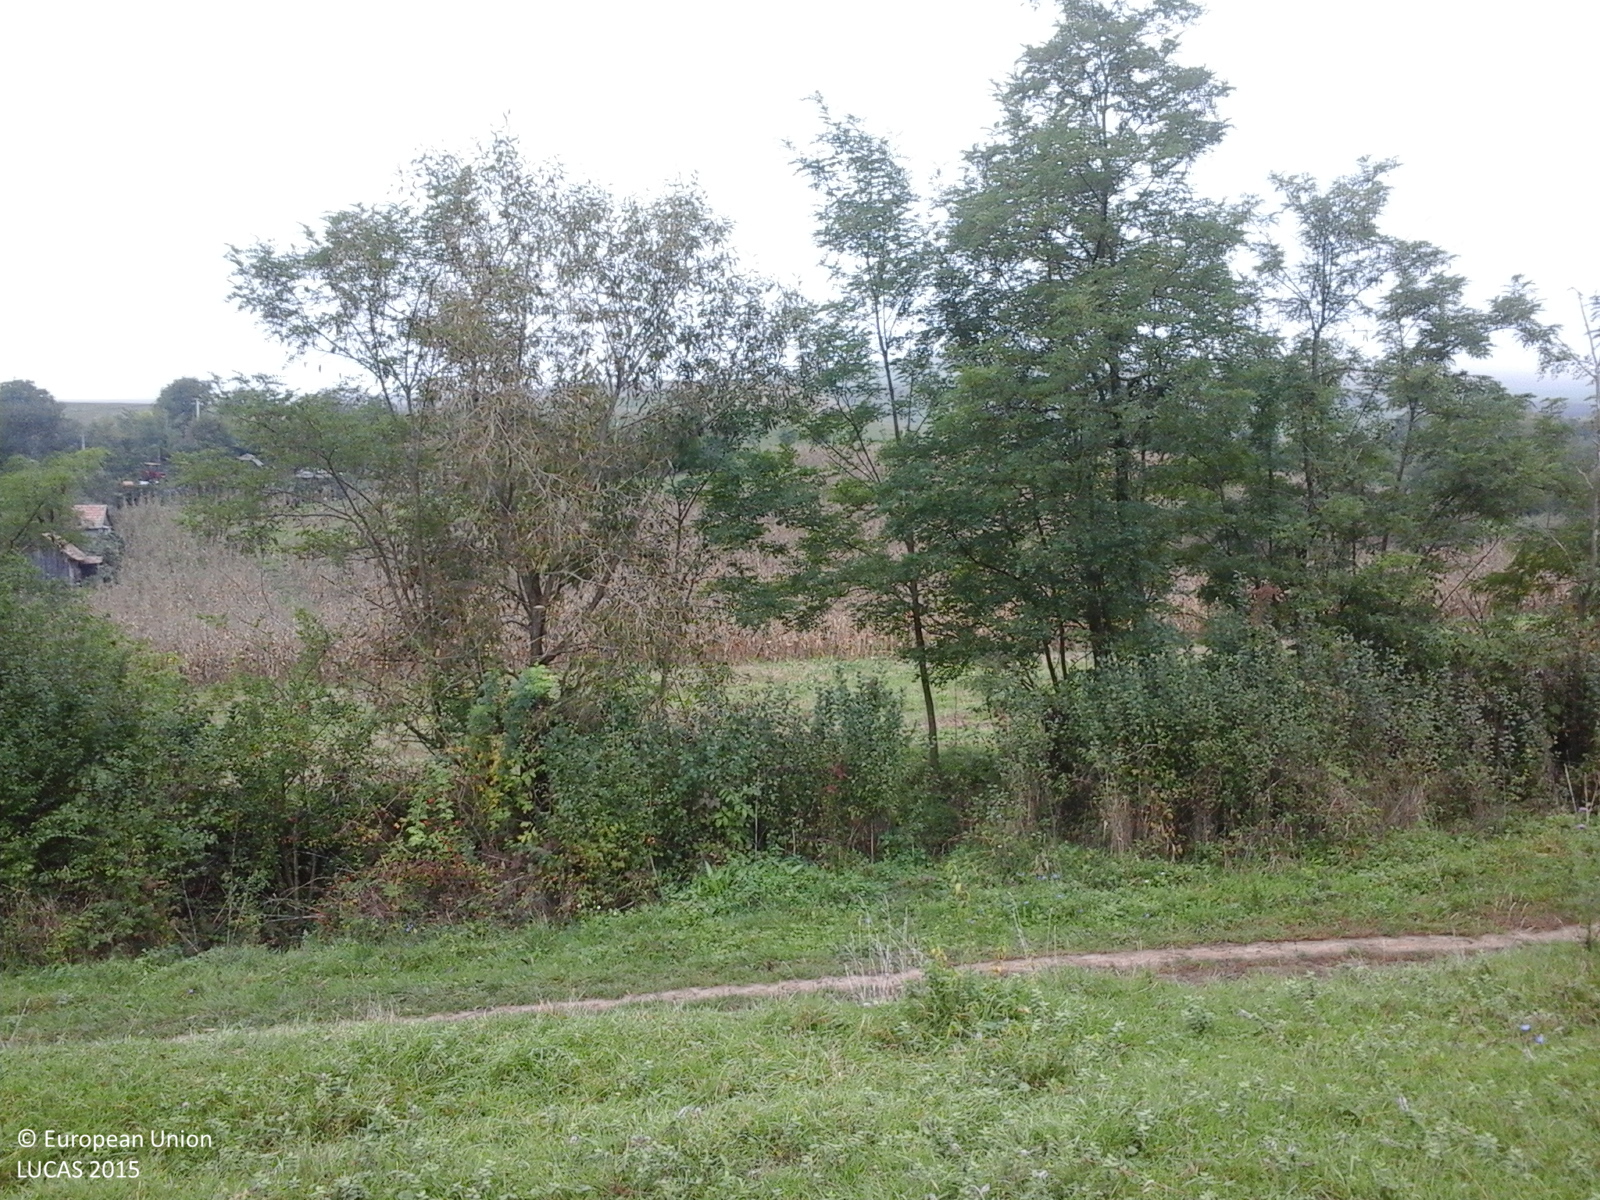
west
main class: Cropland
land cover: Nuts trees
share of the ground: > 75 %
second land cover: Grassland without tree/shrub cover
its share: > 75 %
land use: Agriculture (excluding fallow land and kitchen gardens)
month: October
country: RO
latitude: 46.6083
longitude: 24.1685
